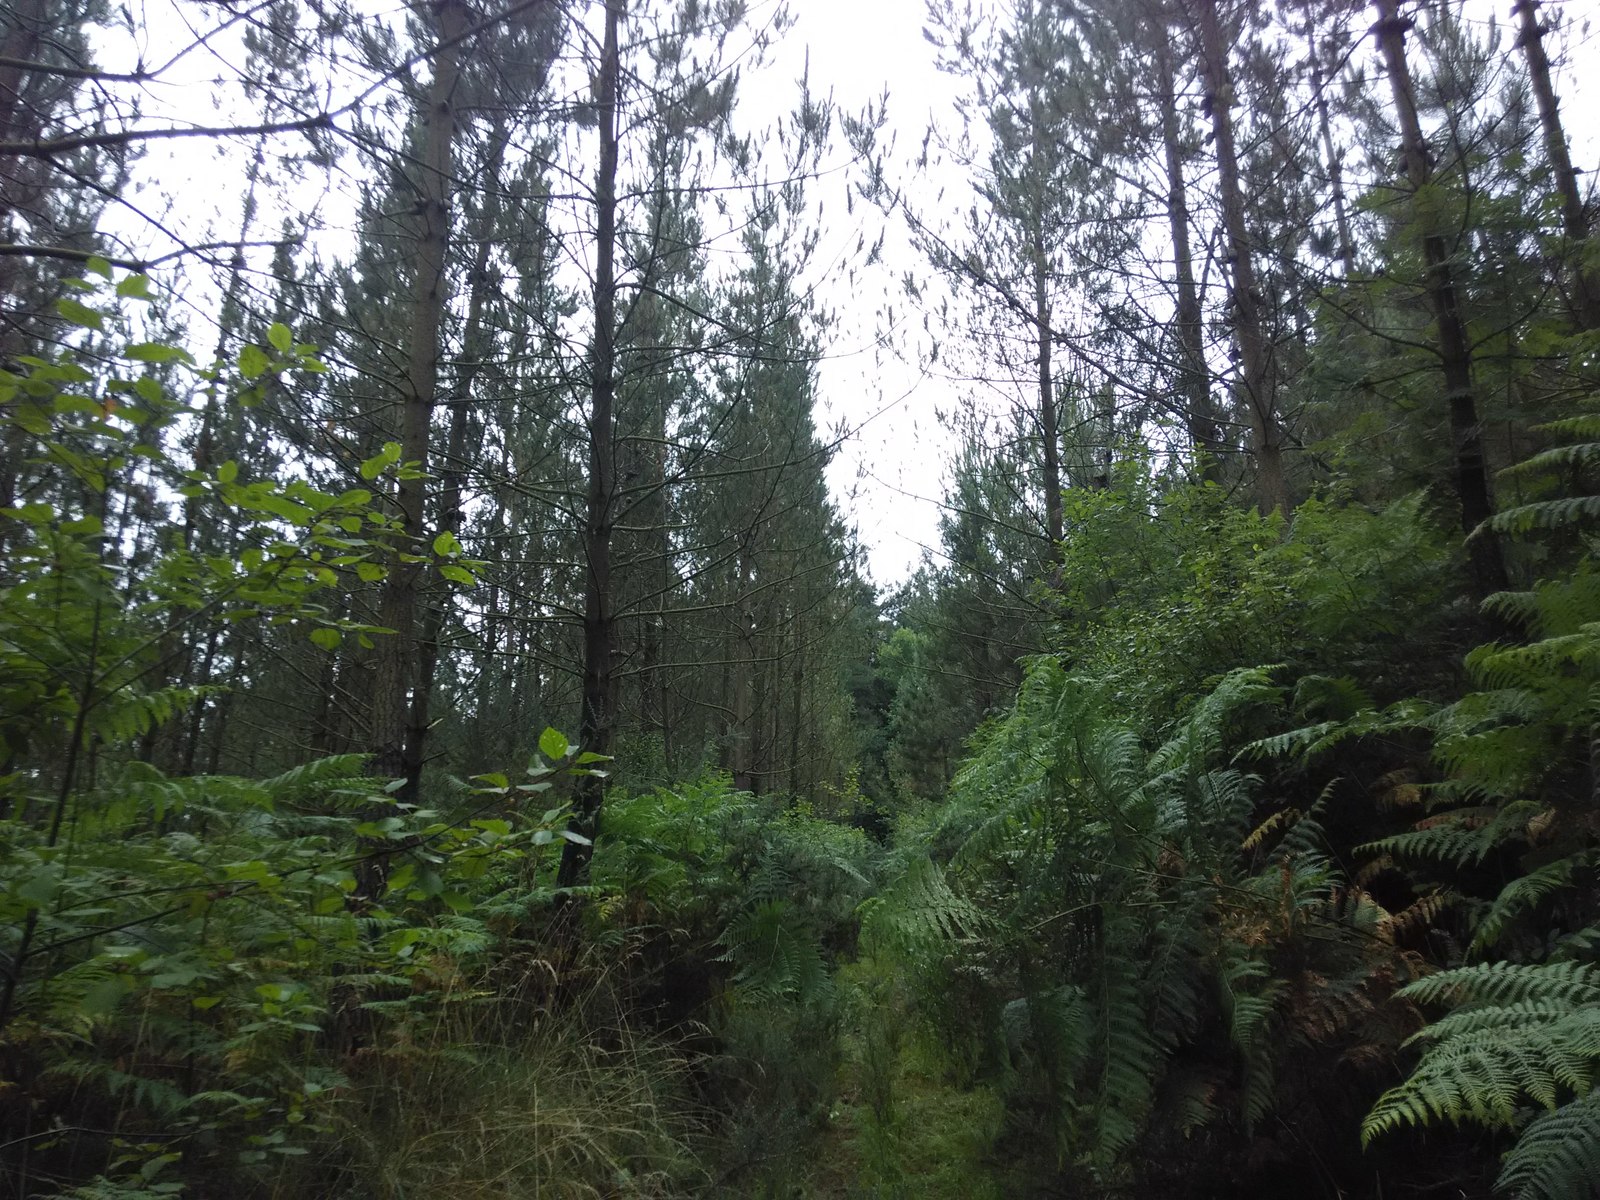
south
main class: Woodland
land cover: Pine dominated coniferous woodland
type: exotic forest
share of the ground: > 75 %
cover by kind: coniferous forest trees 90 %, unconsolidated bare surface 10 %
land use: Forestry
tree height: > 5 m
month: July
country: ES
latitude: 43.0934
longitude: -2.3969
